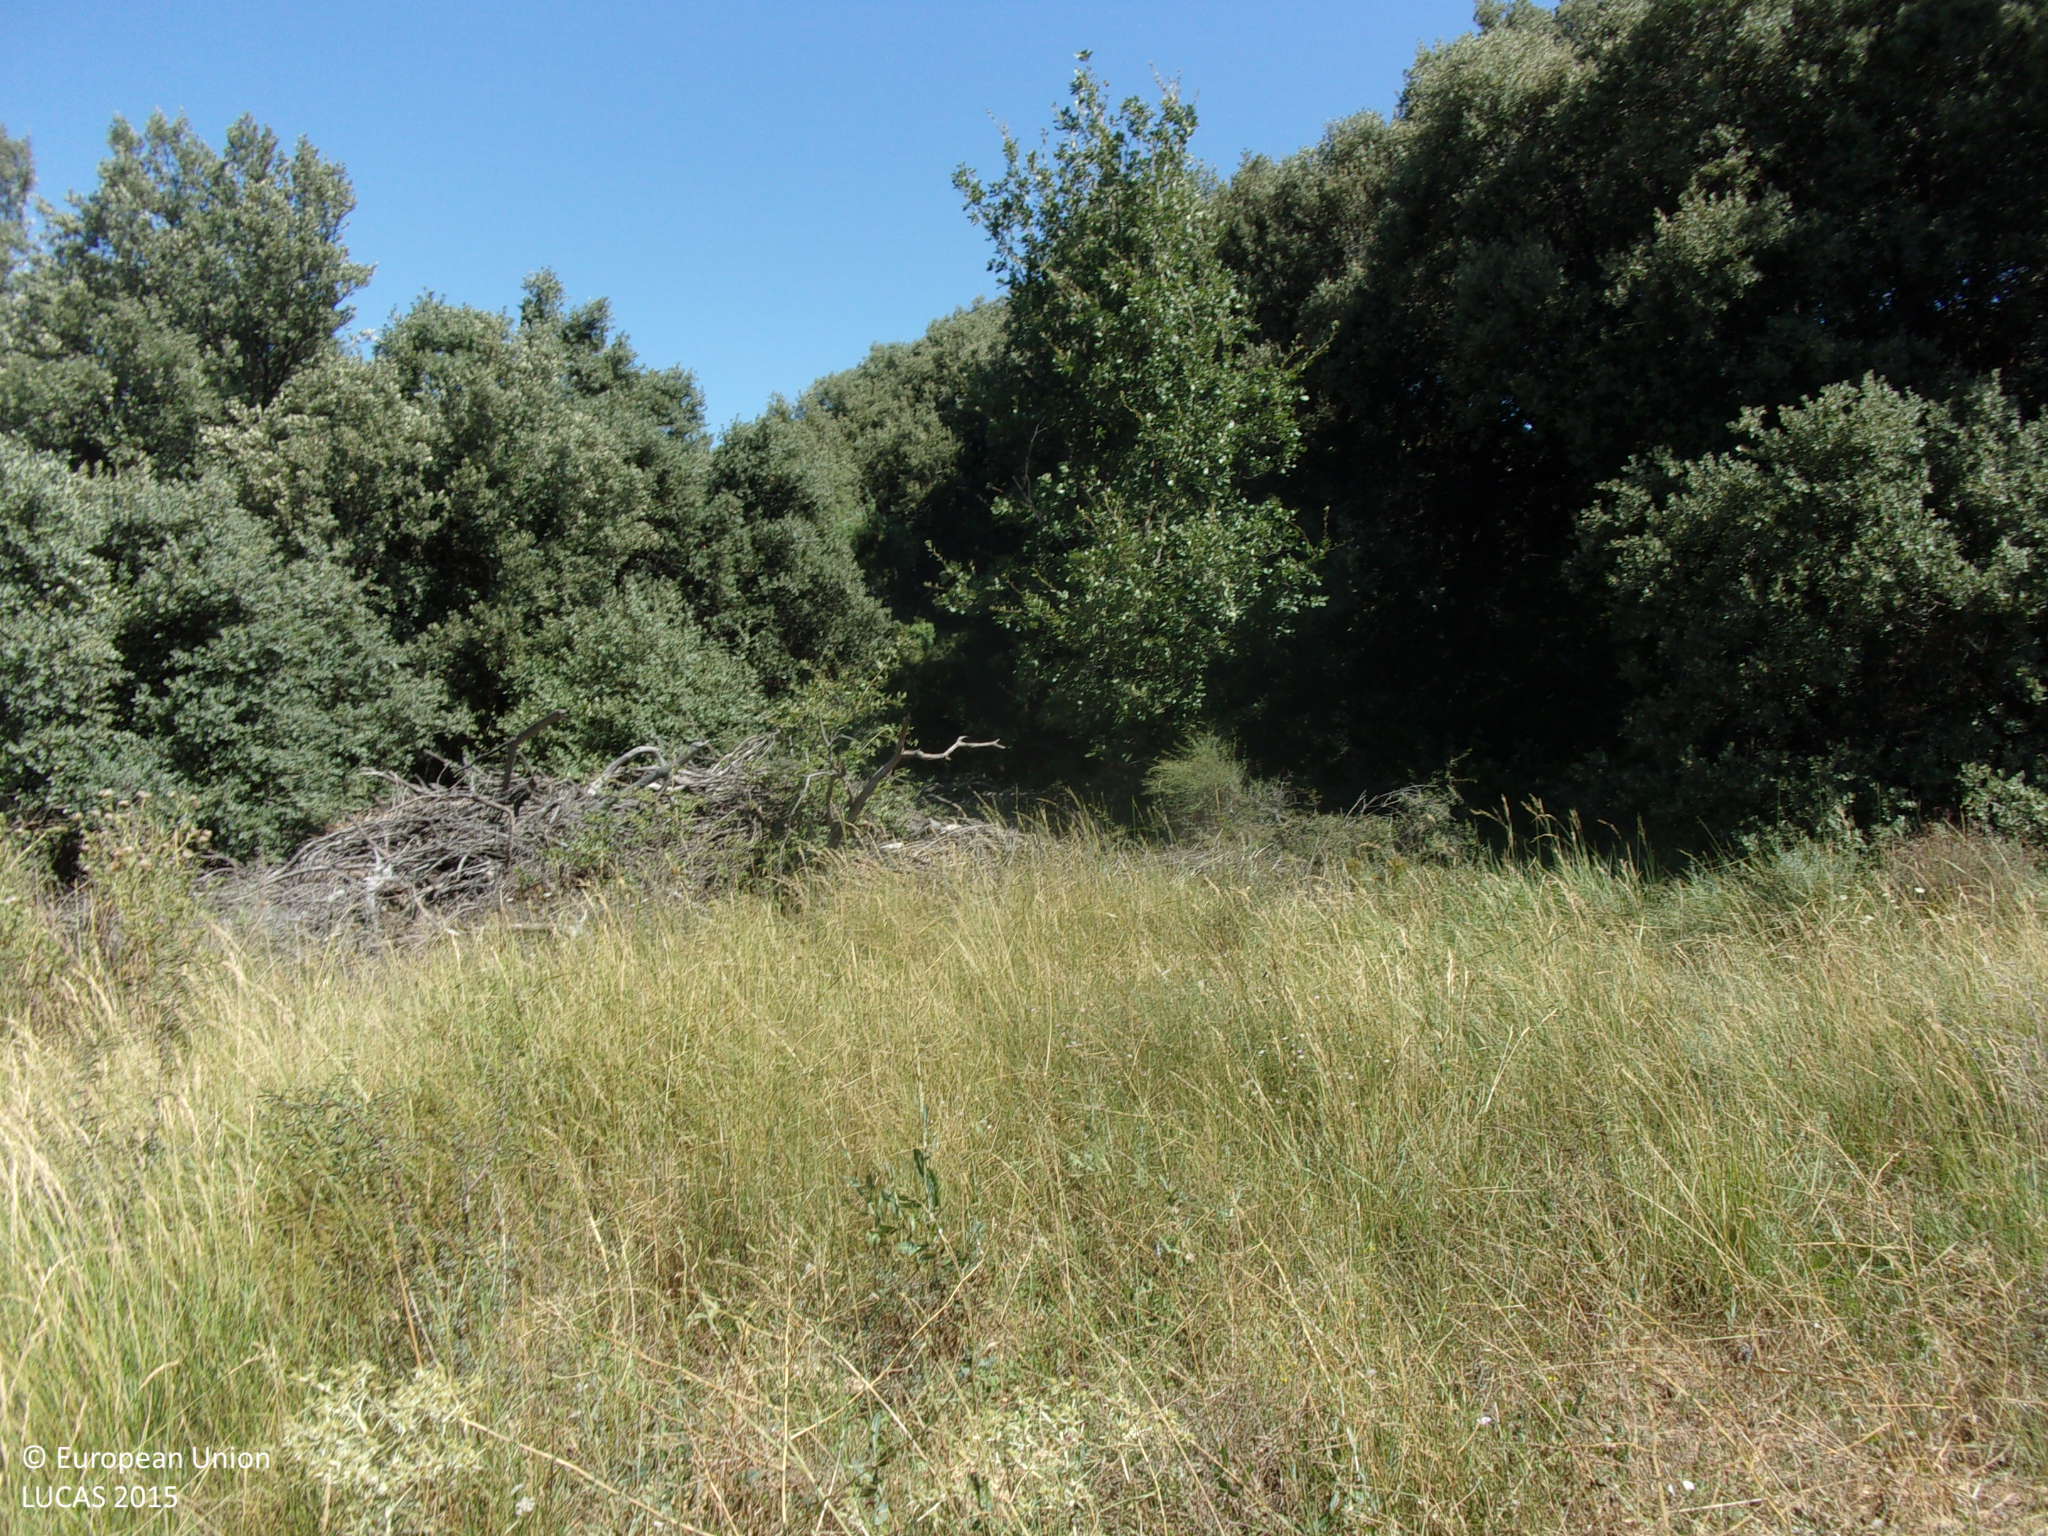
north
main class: Woodland
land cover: Broadleaved woodland
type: thermophilous deciduous forest
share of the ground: > 75 %
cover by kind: broadleaved forest trees 90 %, shrubs 10 %
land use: Forestry
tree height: < 5 m
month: August
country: ES
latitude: 42.3805
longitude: -1.1680
